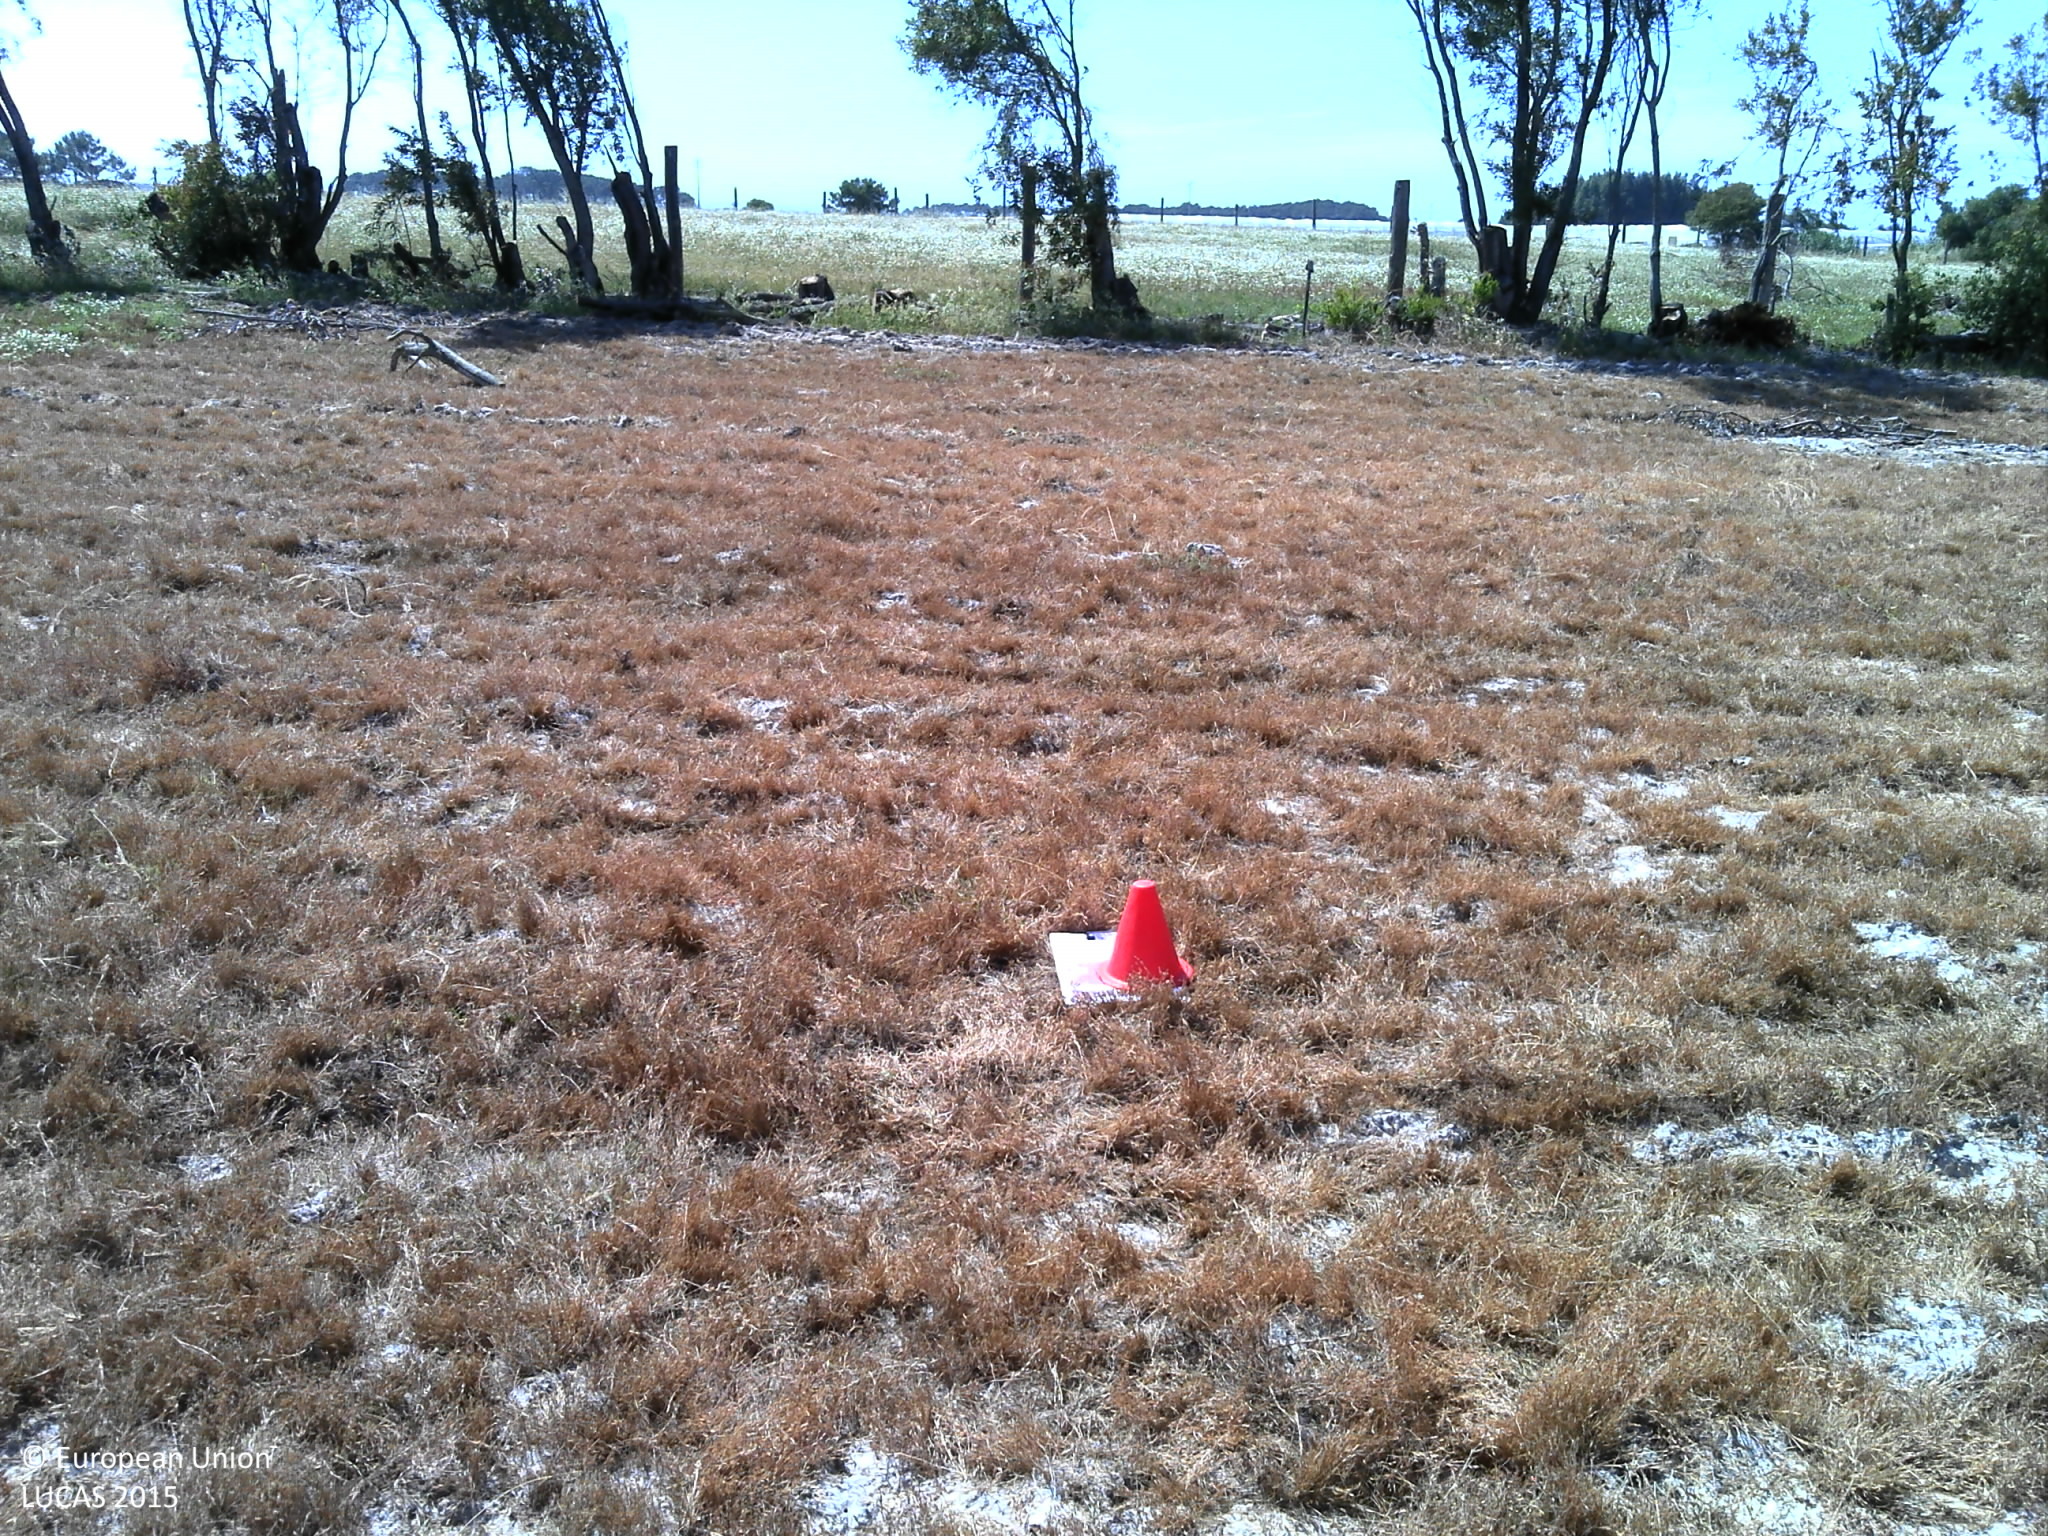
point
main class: Grassland
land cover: Grassland without tree/shrub cover
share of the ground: > 75 %
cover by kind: herbaceous plants 80 %, consolidated bare surface 20 %
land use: Agriculture (excluding fallow land and kitchen gardens)
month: May
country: PT
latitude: 37.5298
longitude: -8.7679
